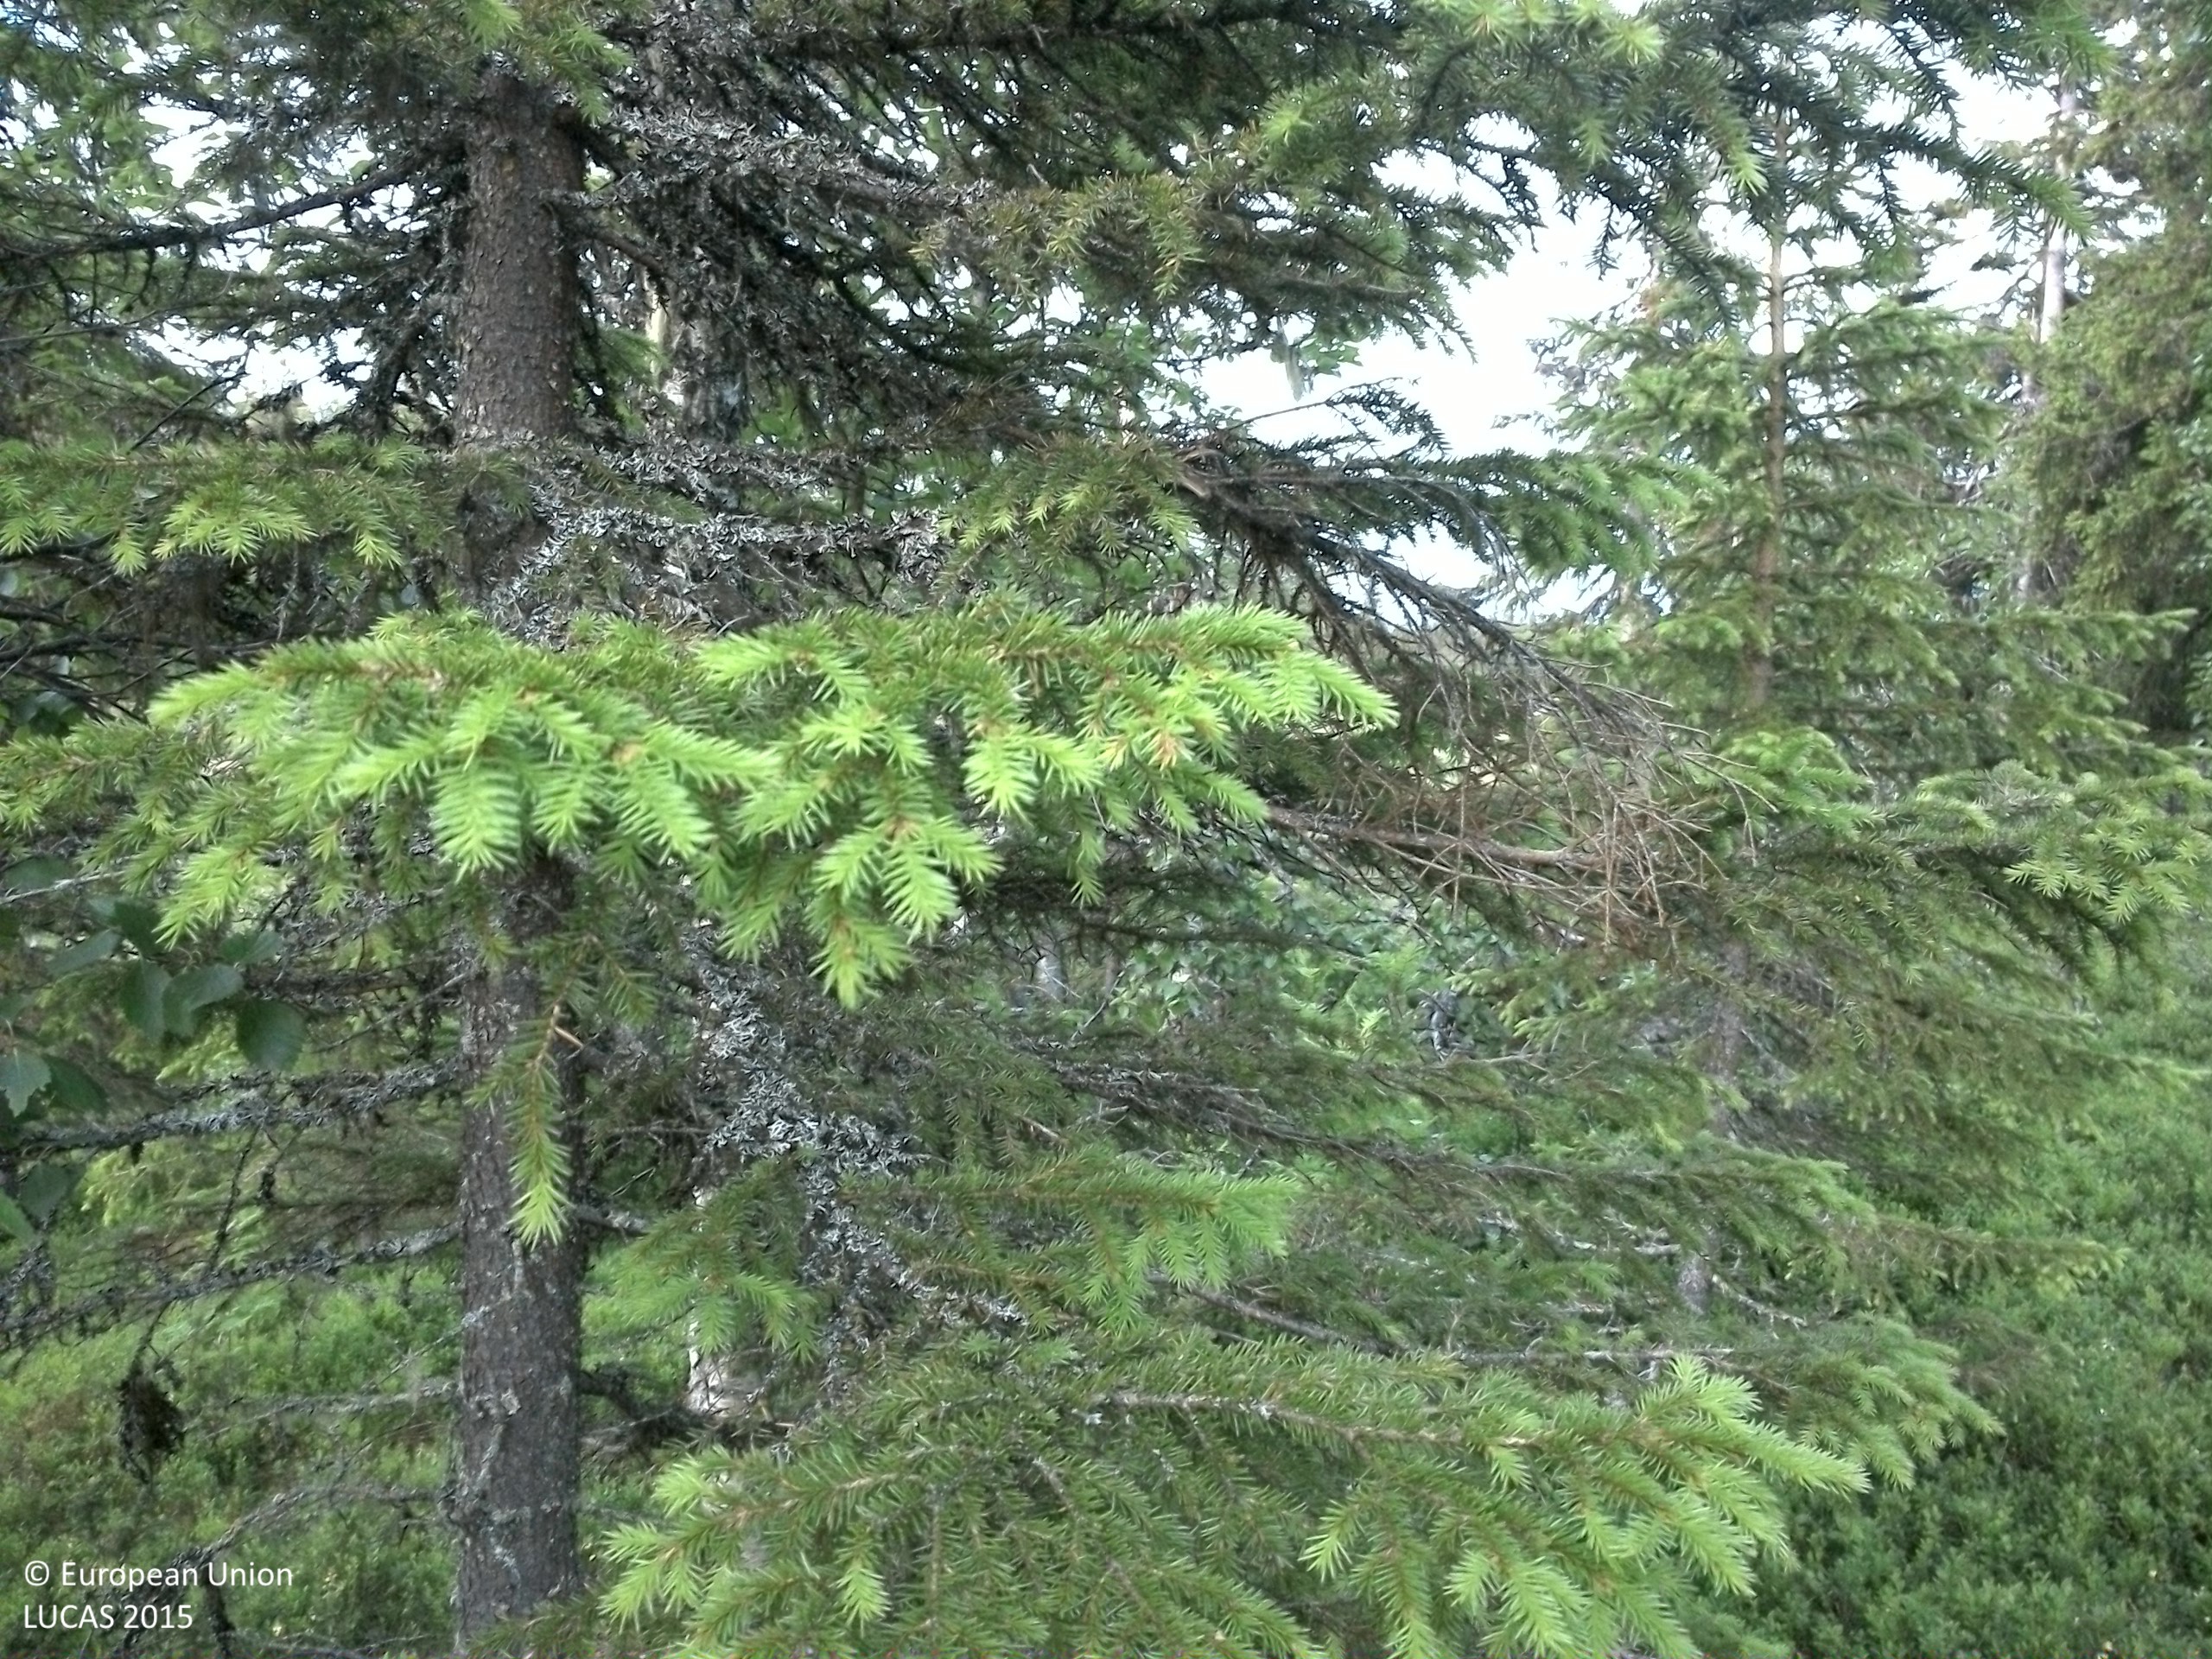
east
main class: Woodland
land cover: Spruce dominated mixed woodland
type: boreal forest
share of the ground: 25 - 50 %
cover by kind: shrubs 50 %, coniferous forest trees 25 %, broadleaved forest trees 15 %, herbaceous plants 10 %
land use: Amenities, museums, leisure
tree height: > 5 m
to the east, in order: Spruce dominated mixed woodland; Shrubland with sparse tree cover; Peatbogs; Spruce dominated mixed woodland; Broadleaved woodland; Spruce dominated mixed woodland
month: July
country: SE
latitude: 64.6794
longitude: 15.6060
